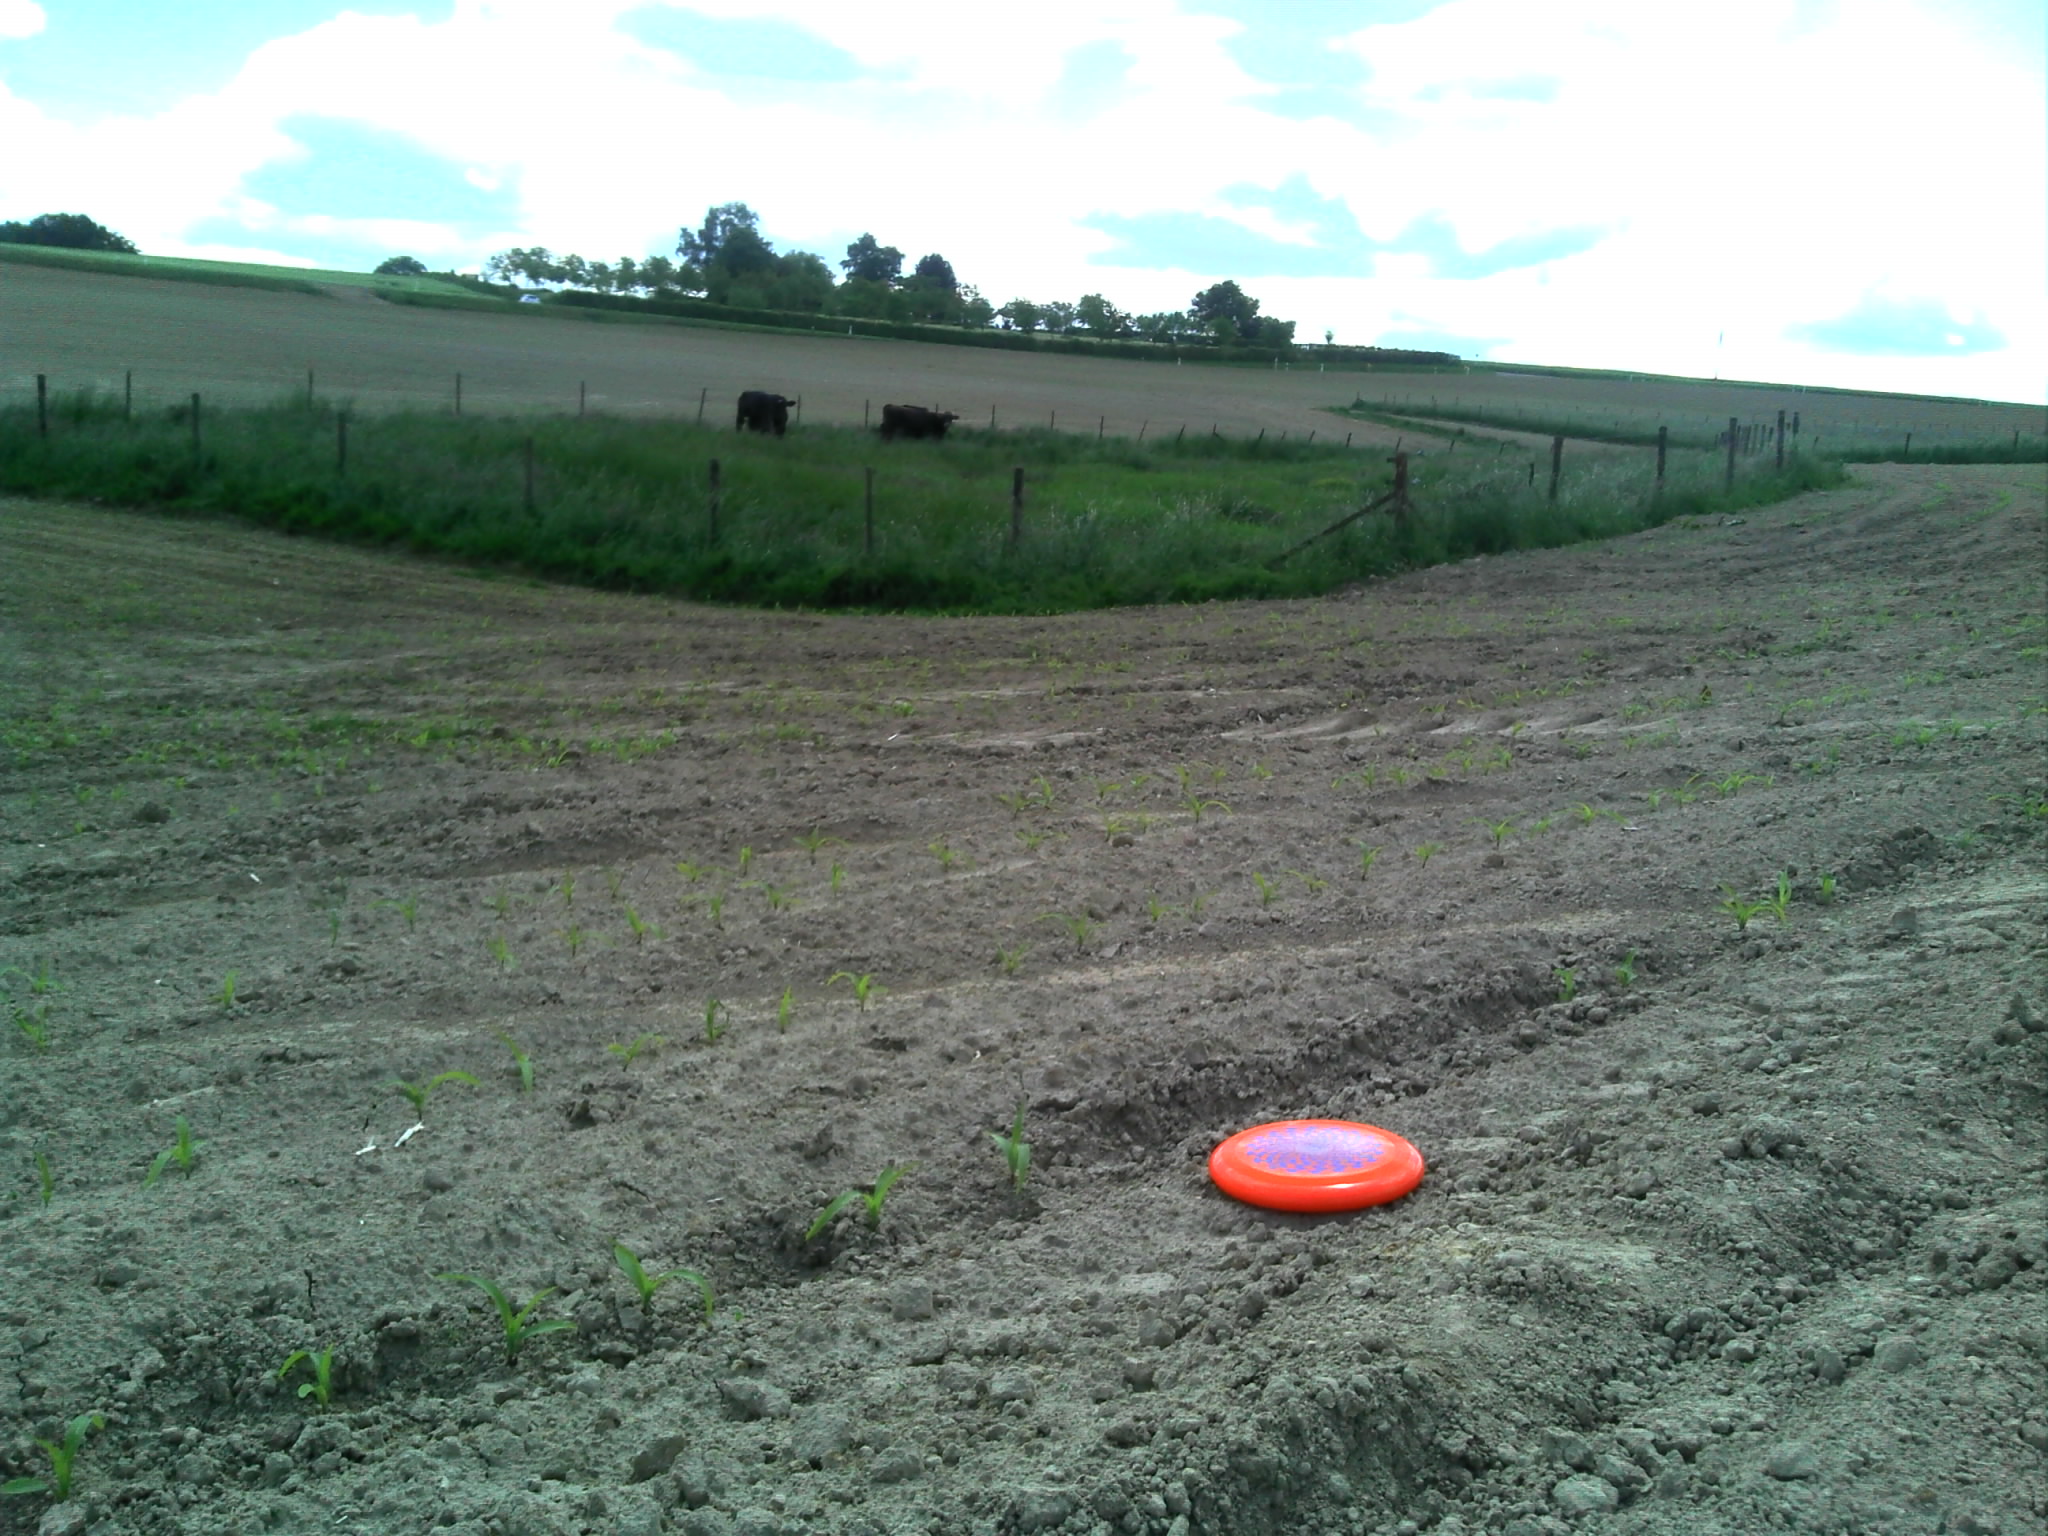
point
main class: Cropland
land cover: Maize
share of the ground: > 75 %
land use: Agriculture (excluding fallow land and kitchen gardens)
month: May
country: LU
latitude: 49.5844
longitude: 6.3065
